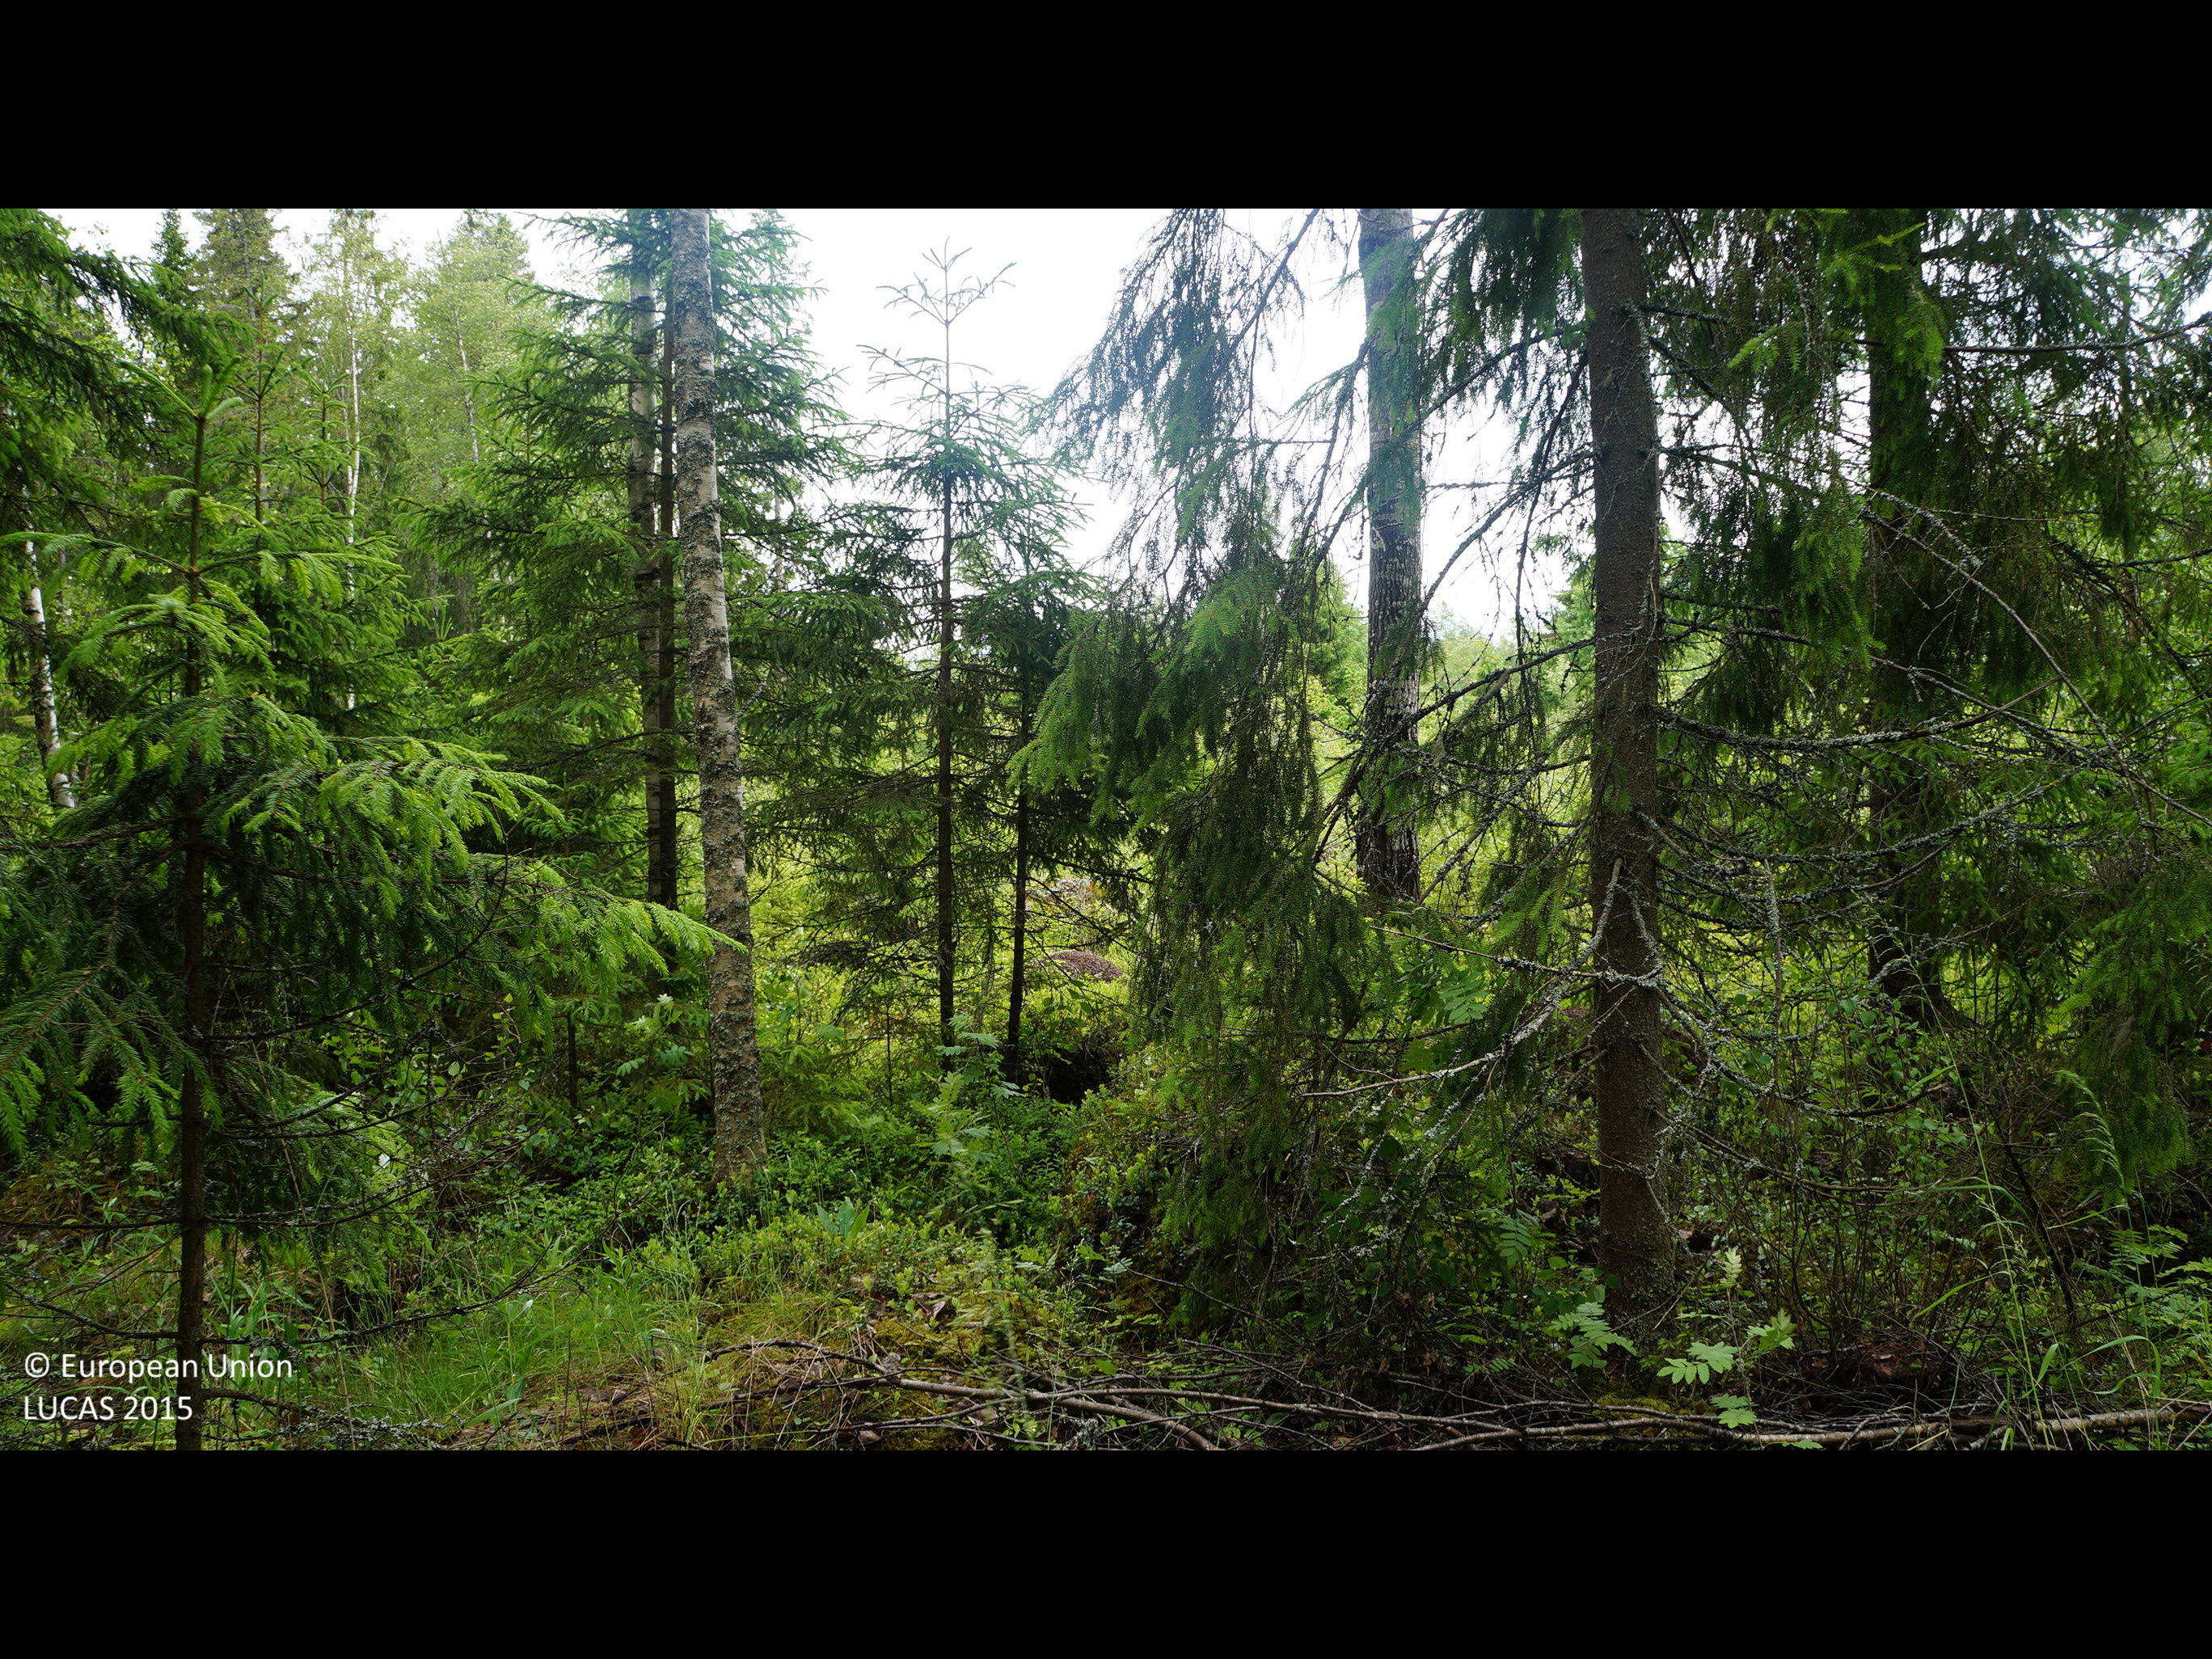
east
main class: Woodland
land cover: Spruce dominated coniferous woodland
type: boreal forest
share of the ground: 50 - 75 %
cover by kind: coniferous forest trees 45 %, shrubs 25 %, herbaceous plants 20 %, broadleaved forest trees 5 %, lichens and mosses 5 %
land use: Forestry
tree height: > 5 m
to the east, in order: Spruce dominated coniferous woodland; Tracks; Spruce dominated mixed woodland; Shrubland with sparse tree cover; Spruce dominated mixed woodland; Spontaneously vegetated surfaces; Spruce dominated mixed woodland; Other mixed woodland; Spruce dominated mixed woodland
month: June
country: FI
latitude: 63.9001
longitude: 23.4009
